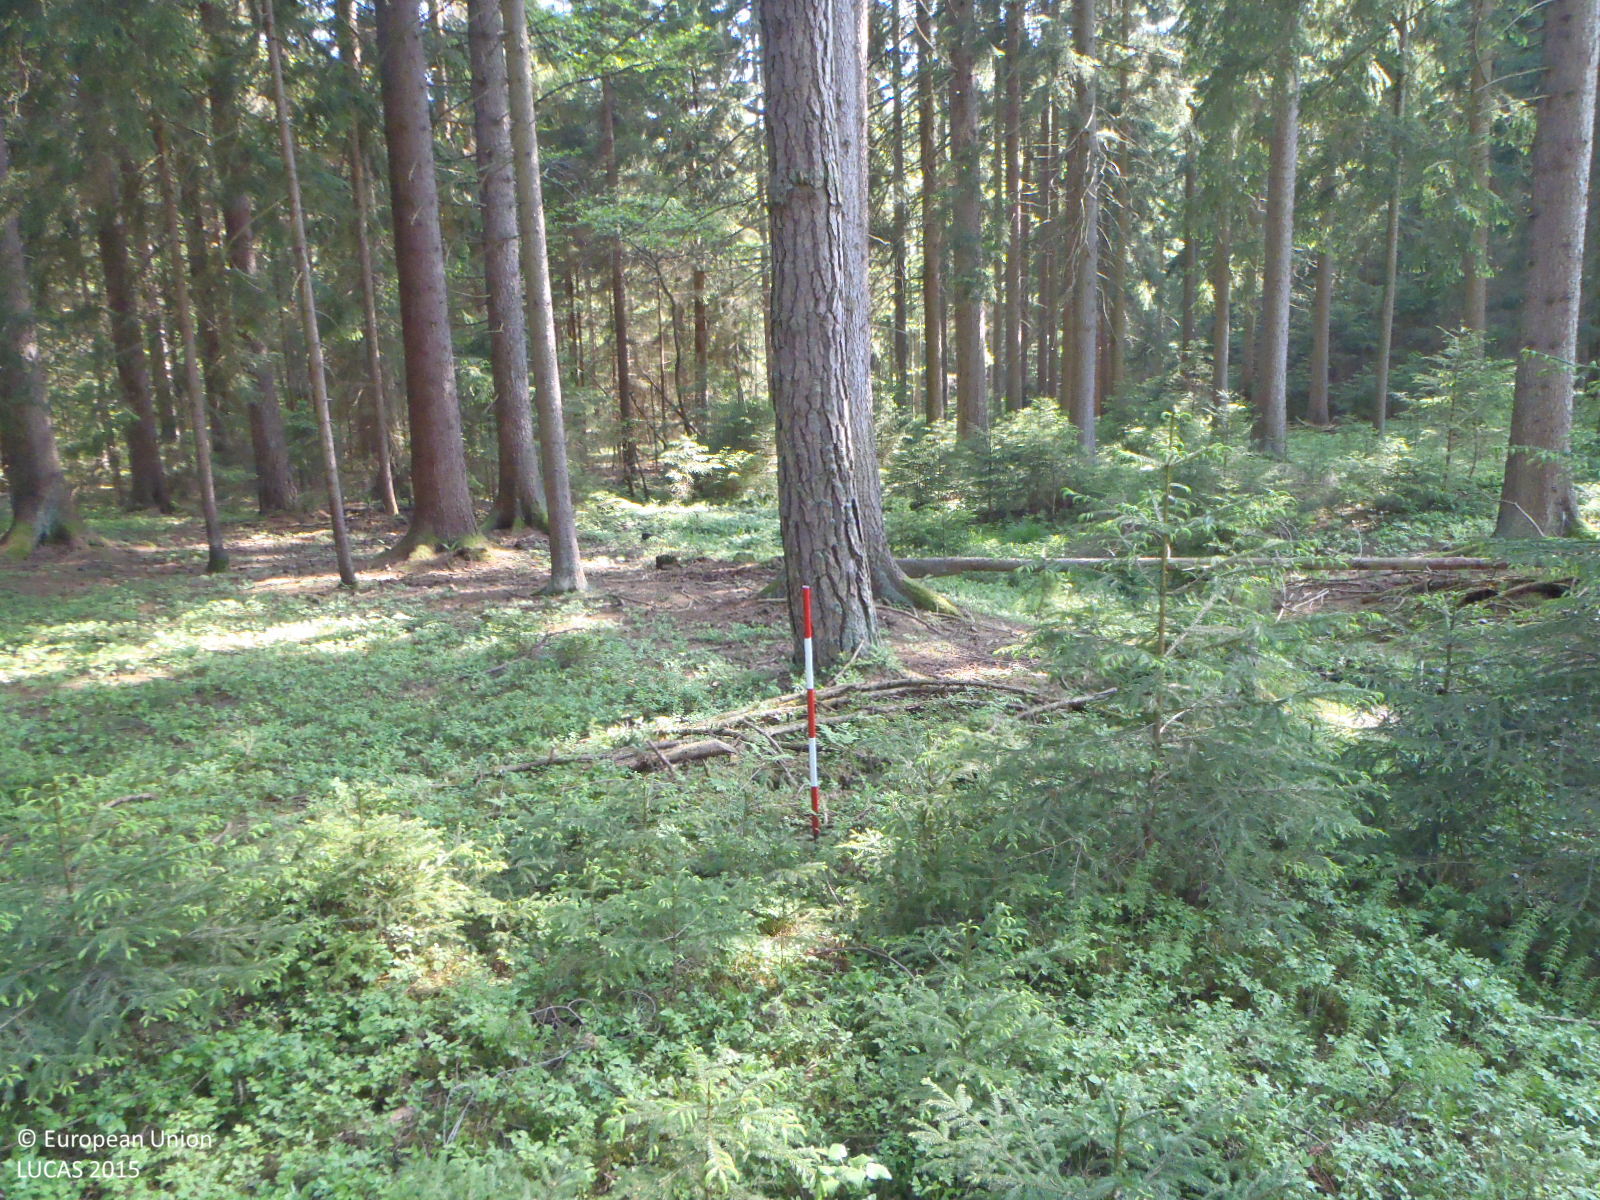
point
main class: Woodland
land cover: Spruce dominated coniferous woodland
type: hemiboreal forest and nemoral coniferous forest and mixed broadleaved-coniferous forest
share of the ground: > 75 %
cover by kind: coniferous forest trees 85 %, shrubs 10 %, lichens and mosses 5 %
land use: Forestry
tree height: > 5 m
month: May
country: CZ
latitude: 48.6523
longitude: 14.5484
